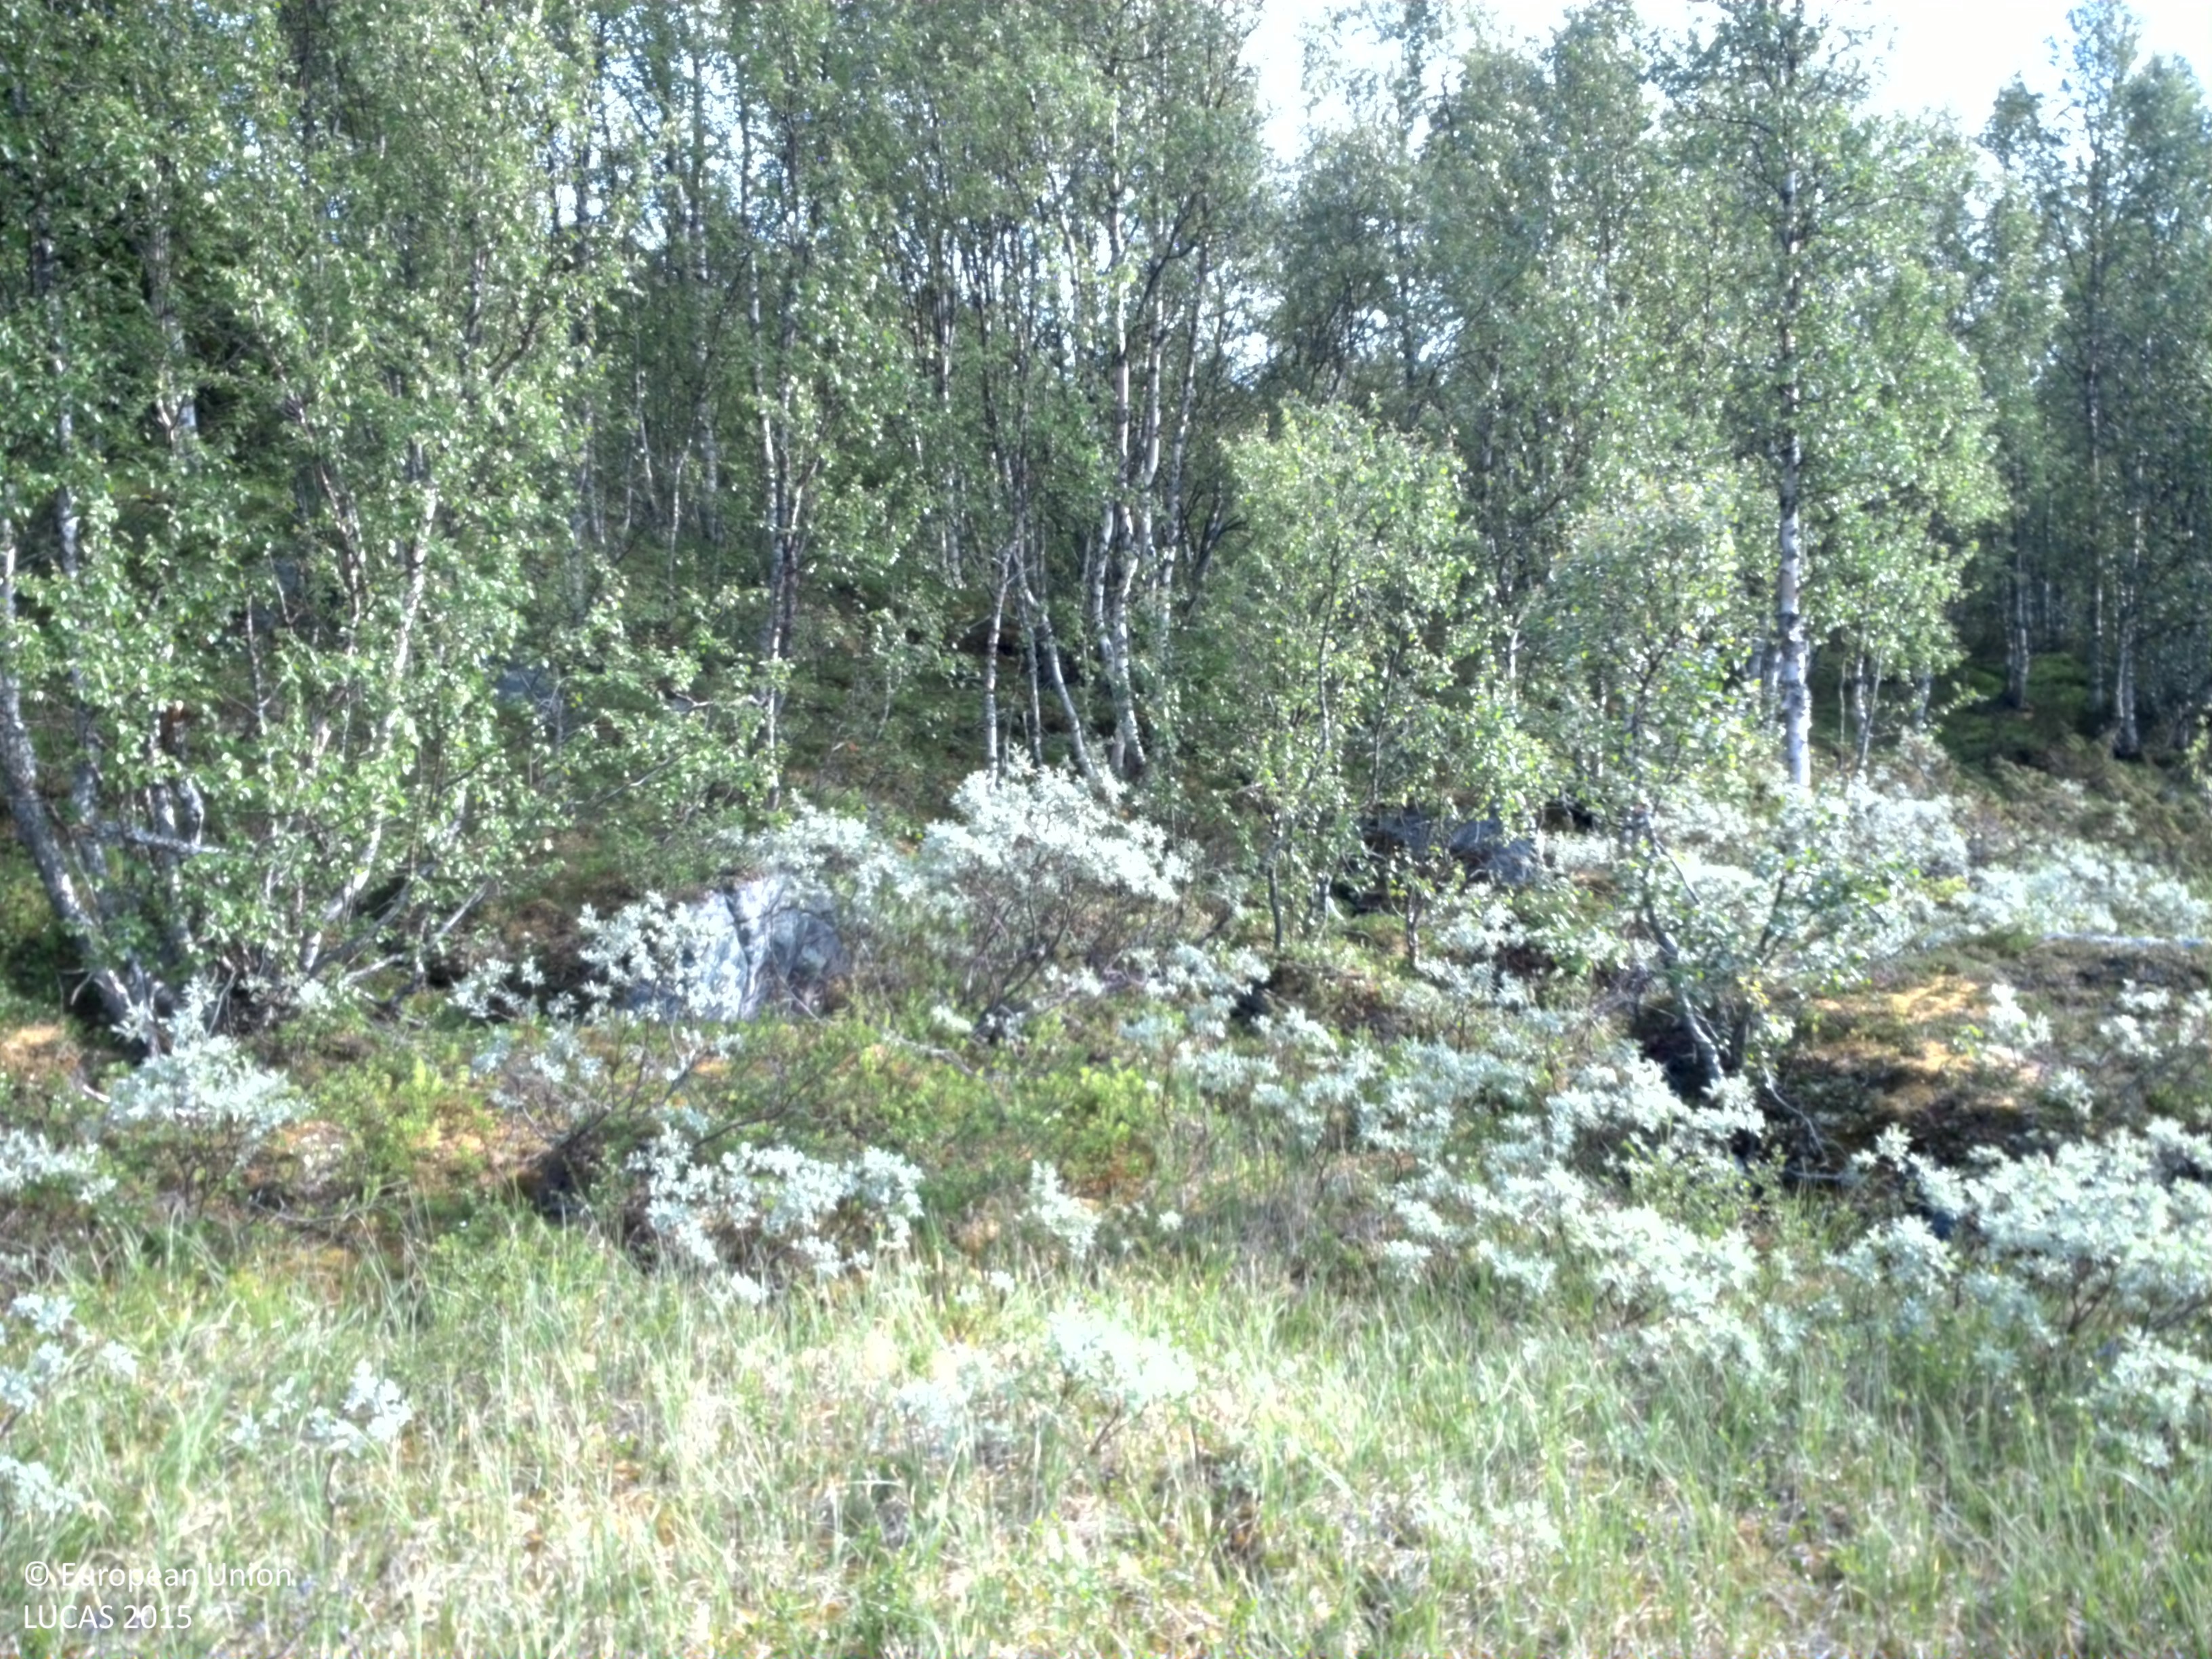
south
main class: Shrubland
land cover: Shrubland without tree cover
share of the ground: 25 - 50 %
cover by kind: herbaceous plants 55 %, shrubs 25 %, lichens and mosses 20 %
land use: Semi-natural and natural areas not in use
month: July
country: SE
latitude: 65.7540
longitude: 15.4411
